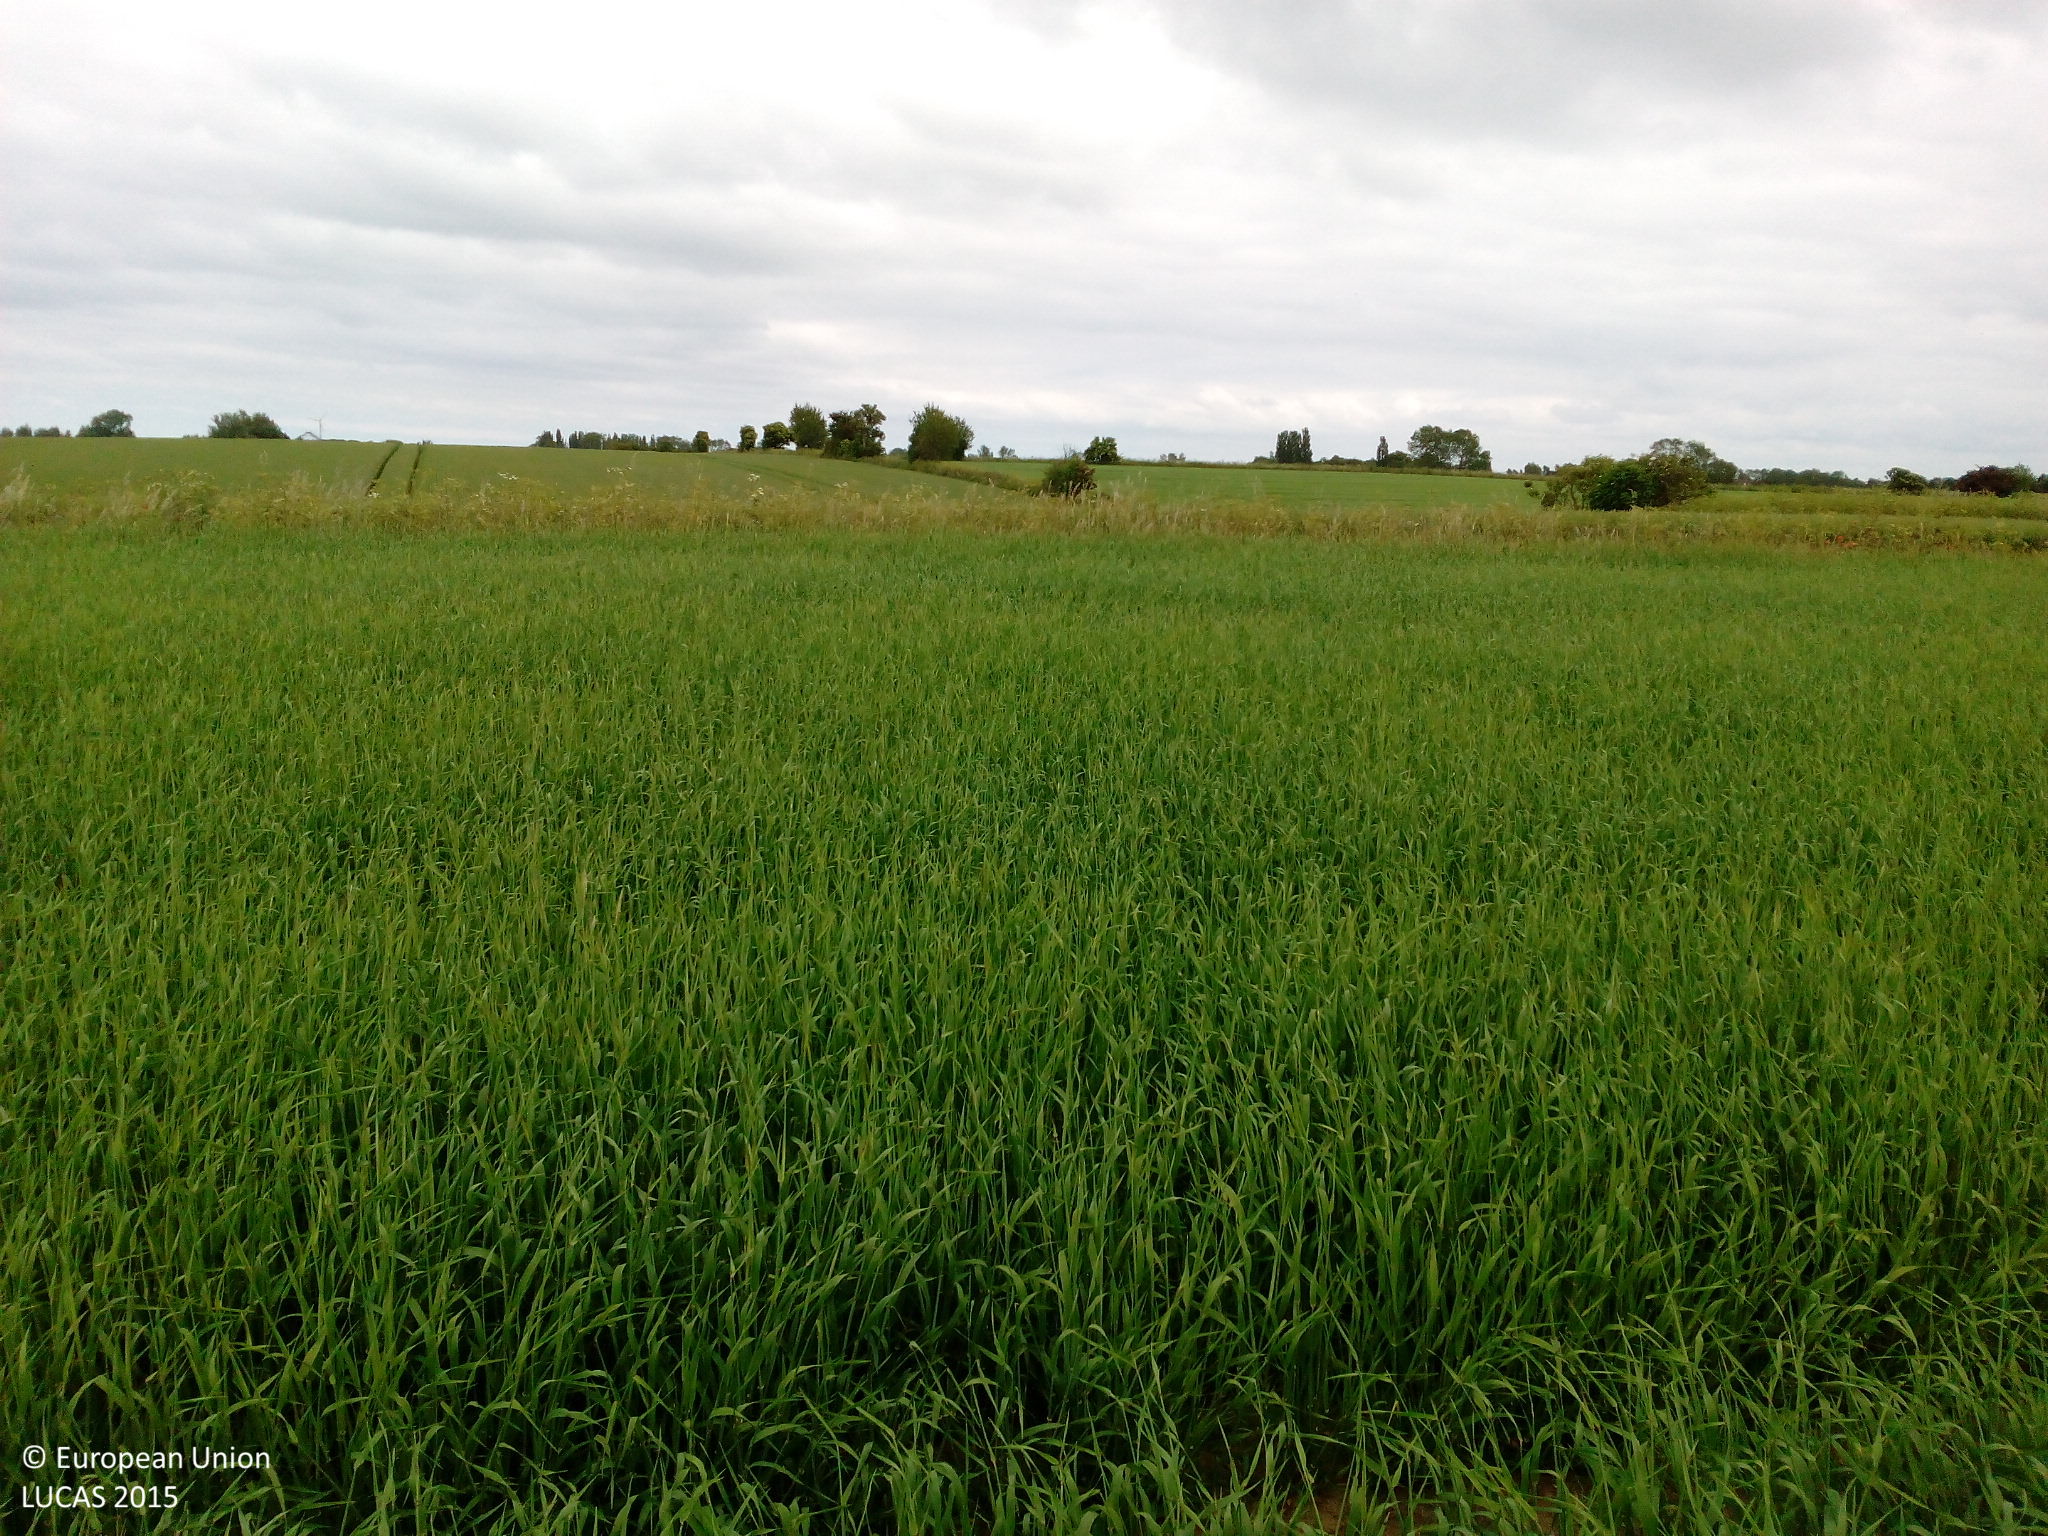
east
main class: Cropland
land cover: Barley
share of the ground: > 75 %
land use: Agriculture (excluding fallow land and kitchen gardens)
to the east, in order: Barley; Grass margins; Paved roads, cycling and walking lanes; Grass margins; Common wheat; Single bushes/trees; Barley
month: June
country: DK
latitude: 54.9575
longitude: 11.4201
